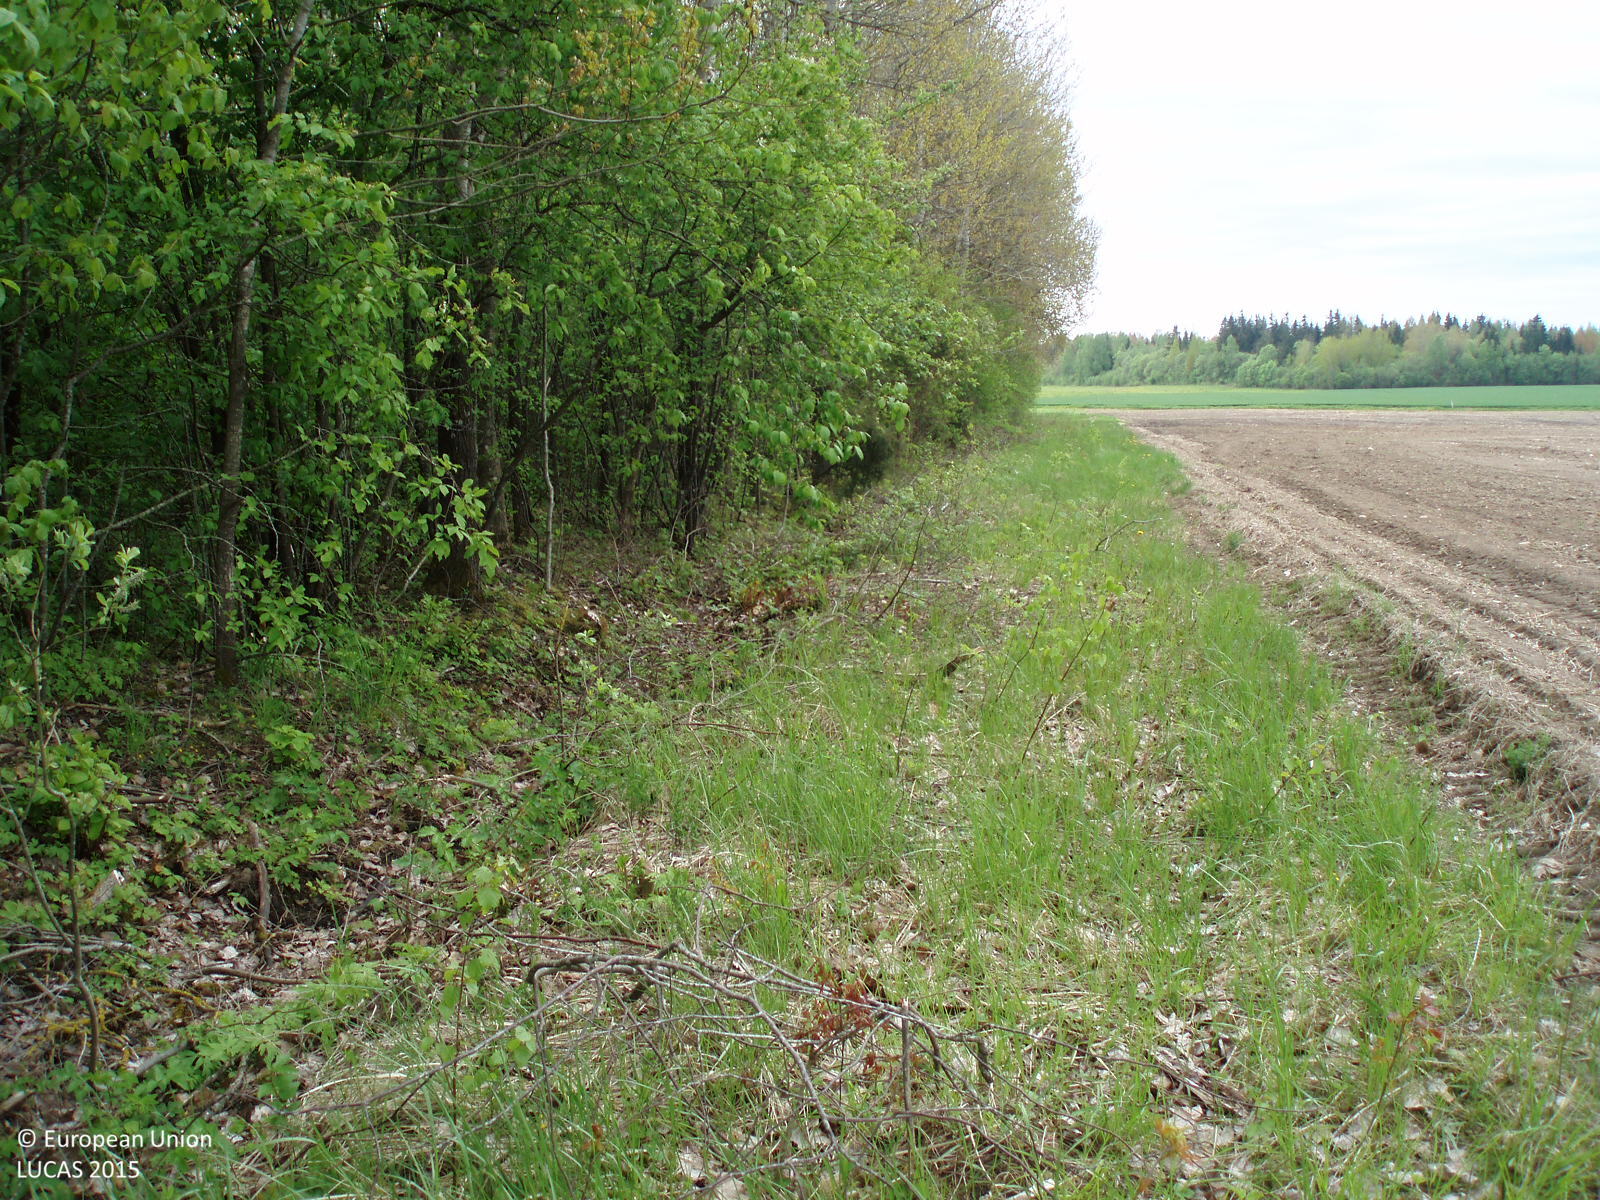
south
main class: Woodland
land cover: Broadleaved woodland
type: non-riverine alder, birch or aspen forest
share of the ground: > 75 %
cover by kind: broadleaved forest trees 90 %, shrubs 5 %, herbaceous plants 5 %
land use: Forestry
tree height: > 5 m
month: May
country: LT
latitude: 56.3629
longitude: 22.4398
